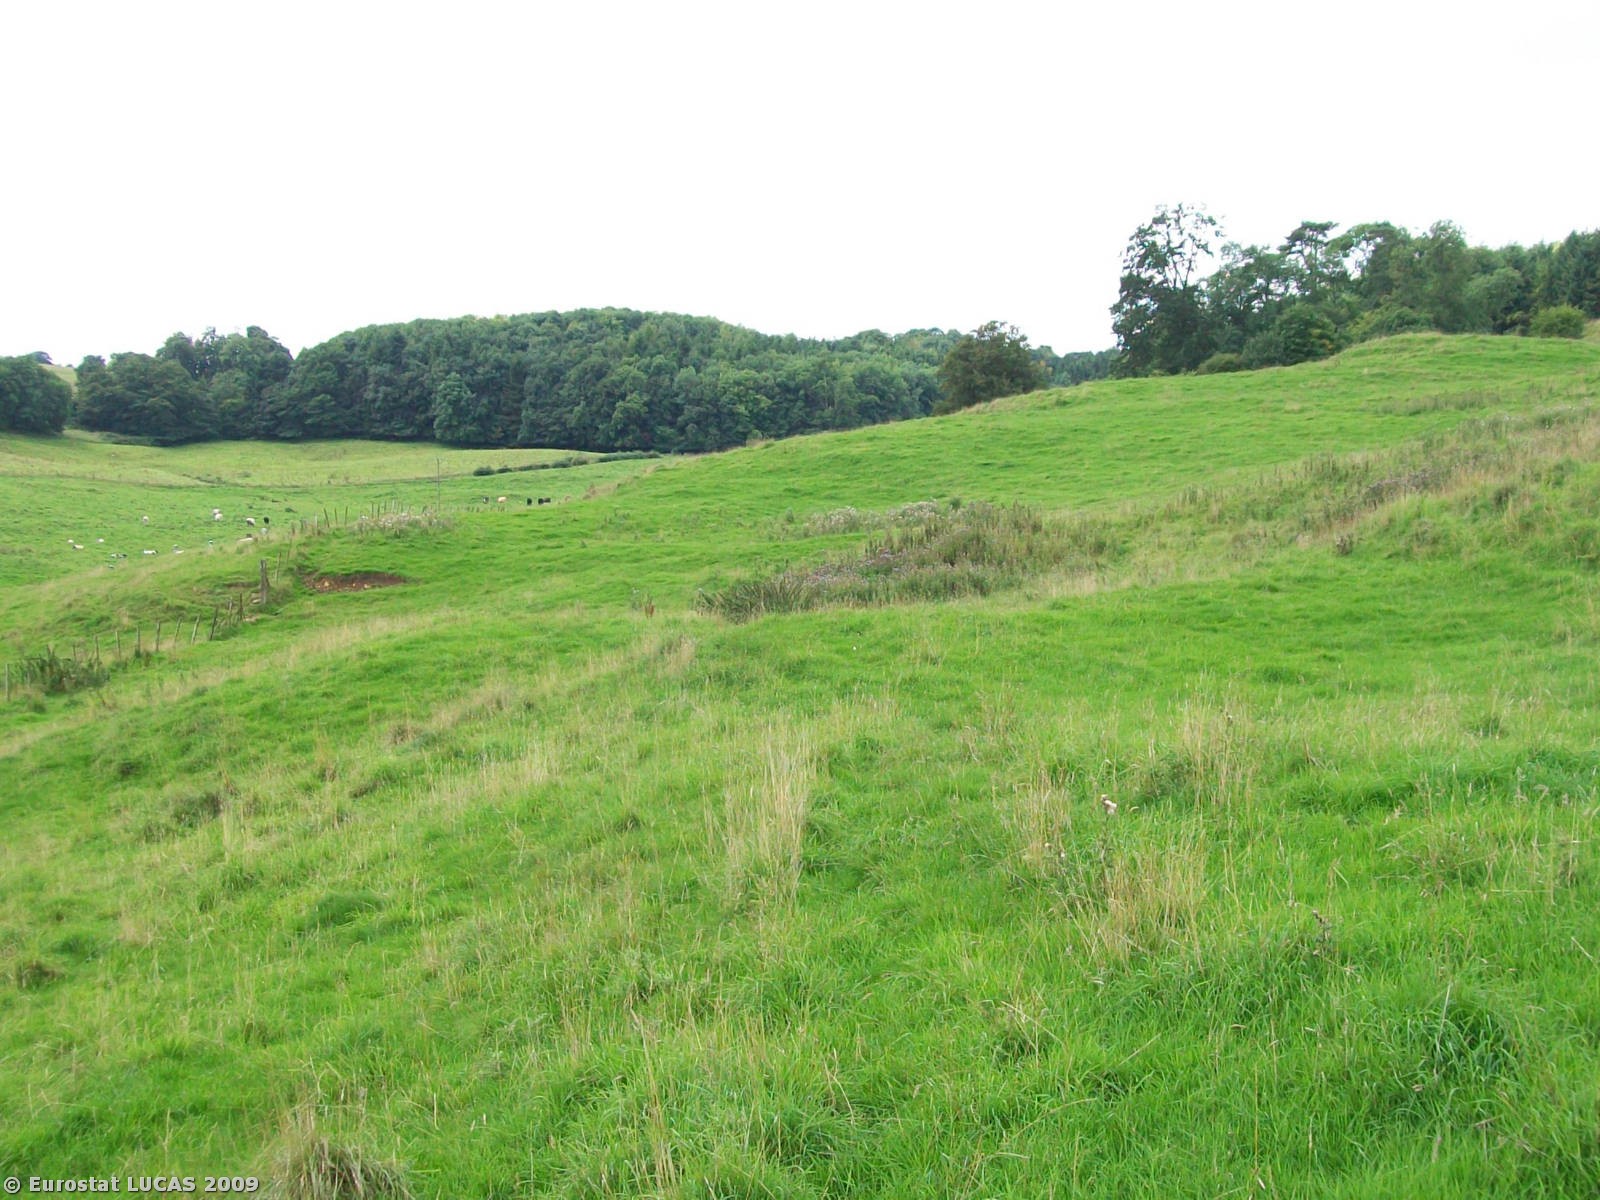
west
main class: Grassland
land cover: Grassland without tree/shrub cover
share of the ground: > 75 %
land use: Agriculture (excluding fallow land and kitchen gardens)
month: August
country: GB
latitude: 51.6672
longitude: -2.2510
